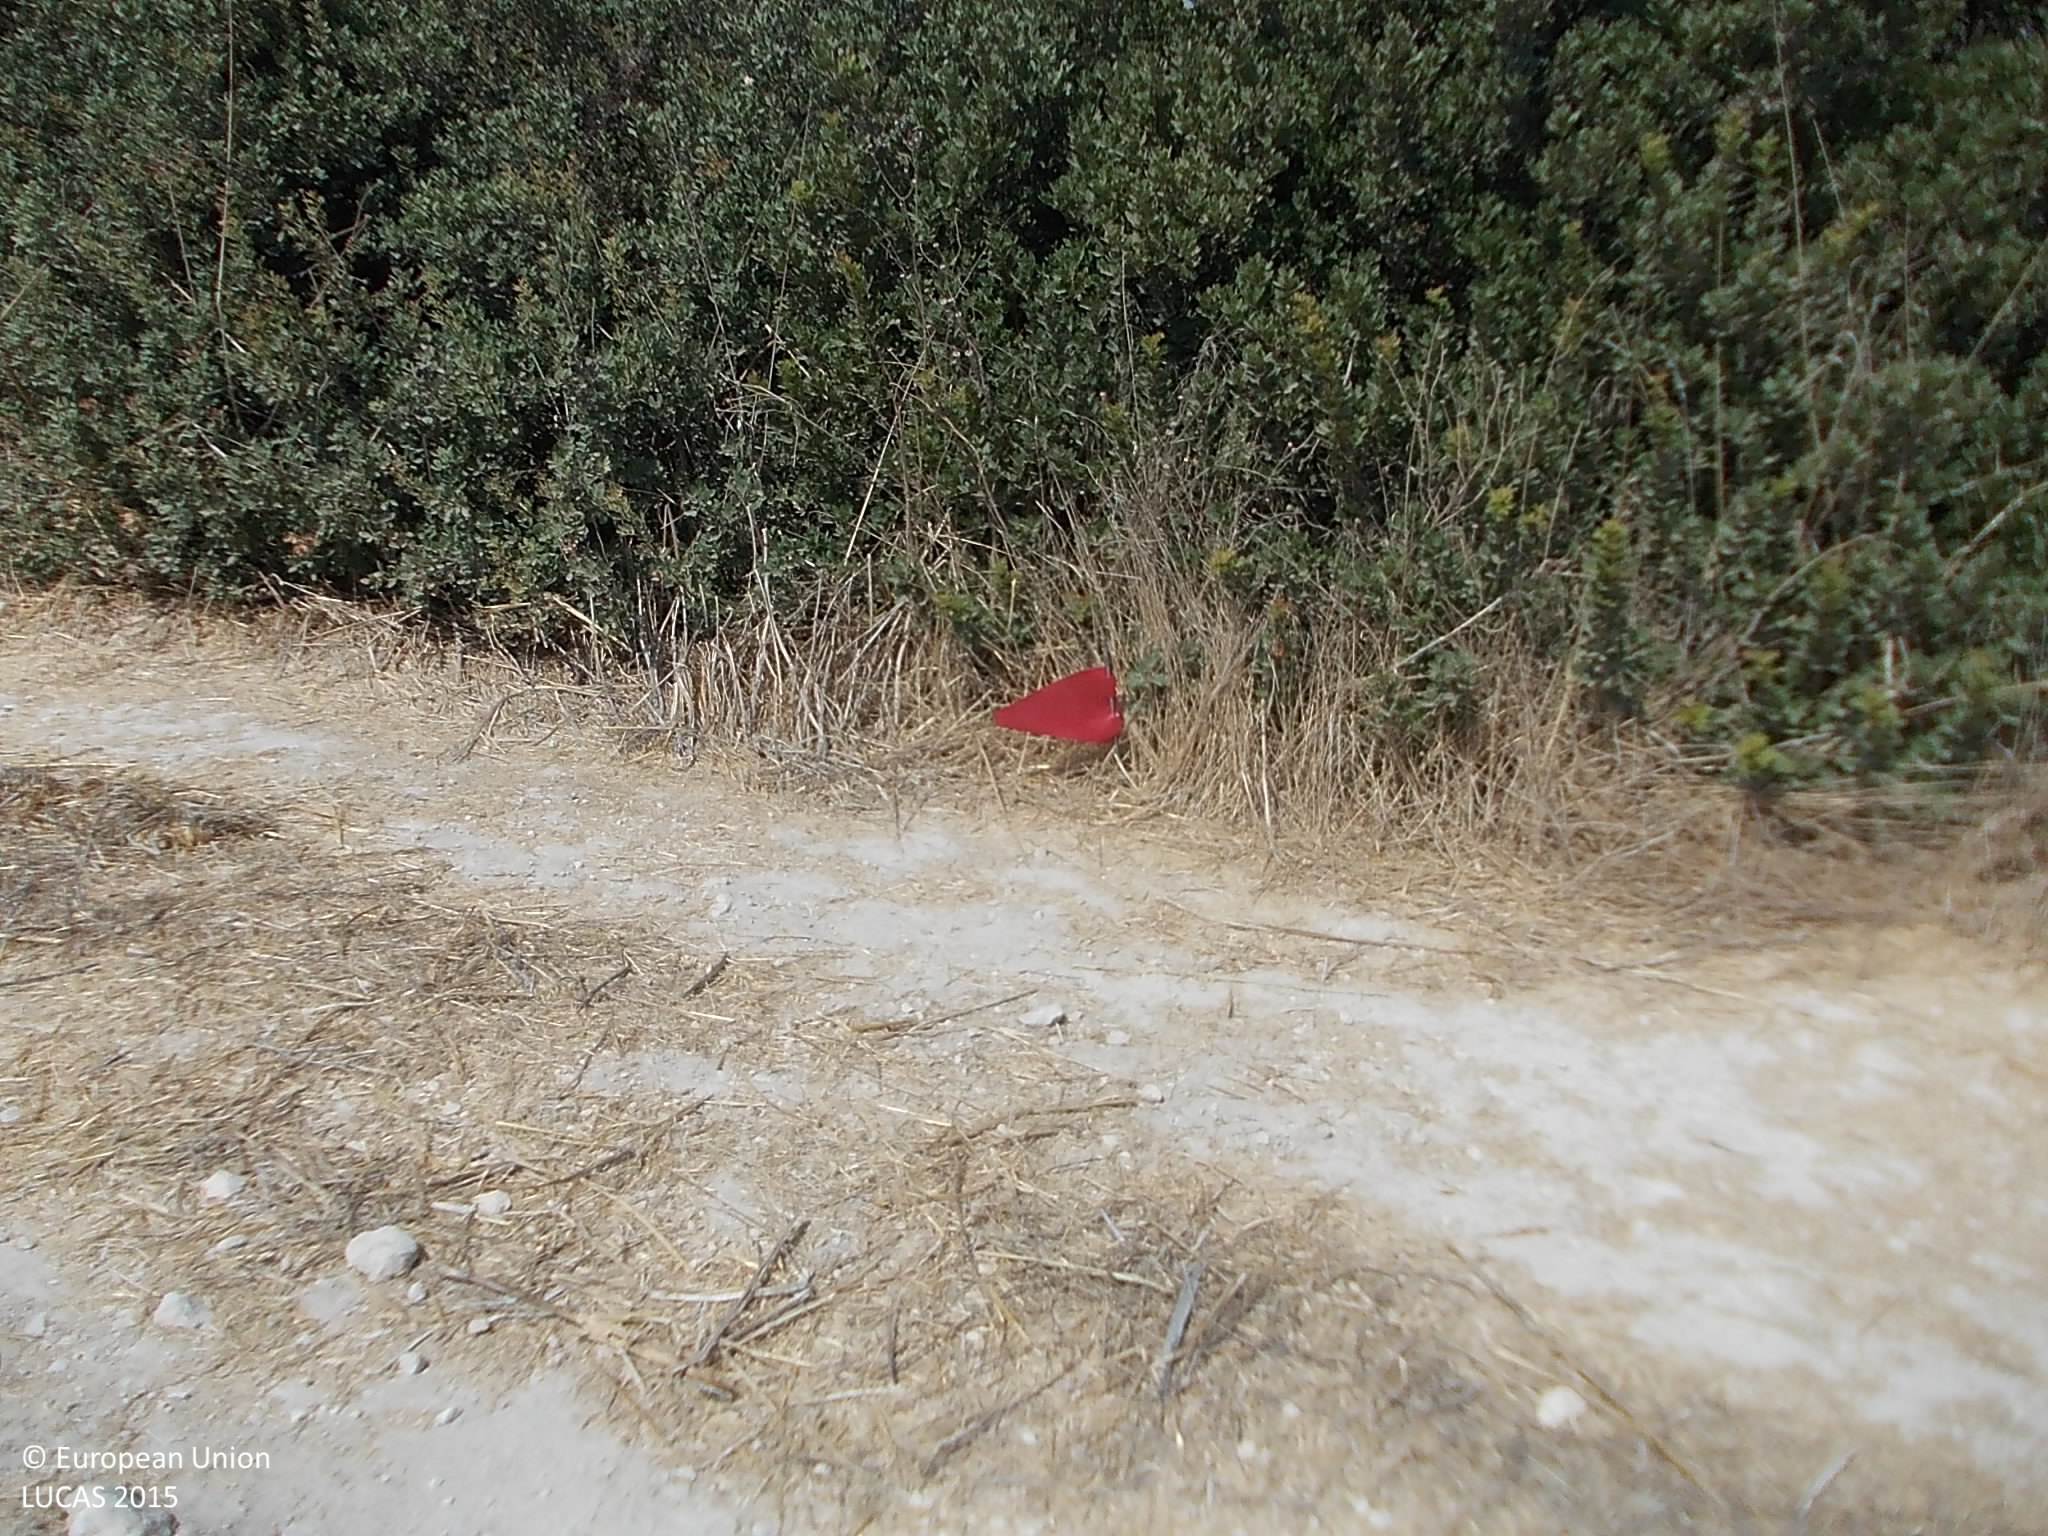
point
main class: Shrubland
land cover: Shrubland without tree cover
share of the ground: > 75 %
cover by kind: shrubs 95 %, herbaceous plants 5 %
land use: Semi-natural and natural areas not in use
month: May
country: CY
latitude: 34.6811
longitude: 32.7807
